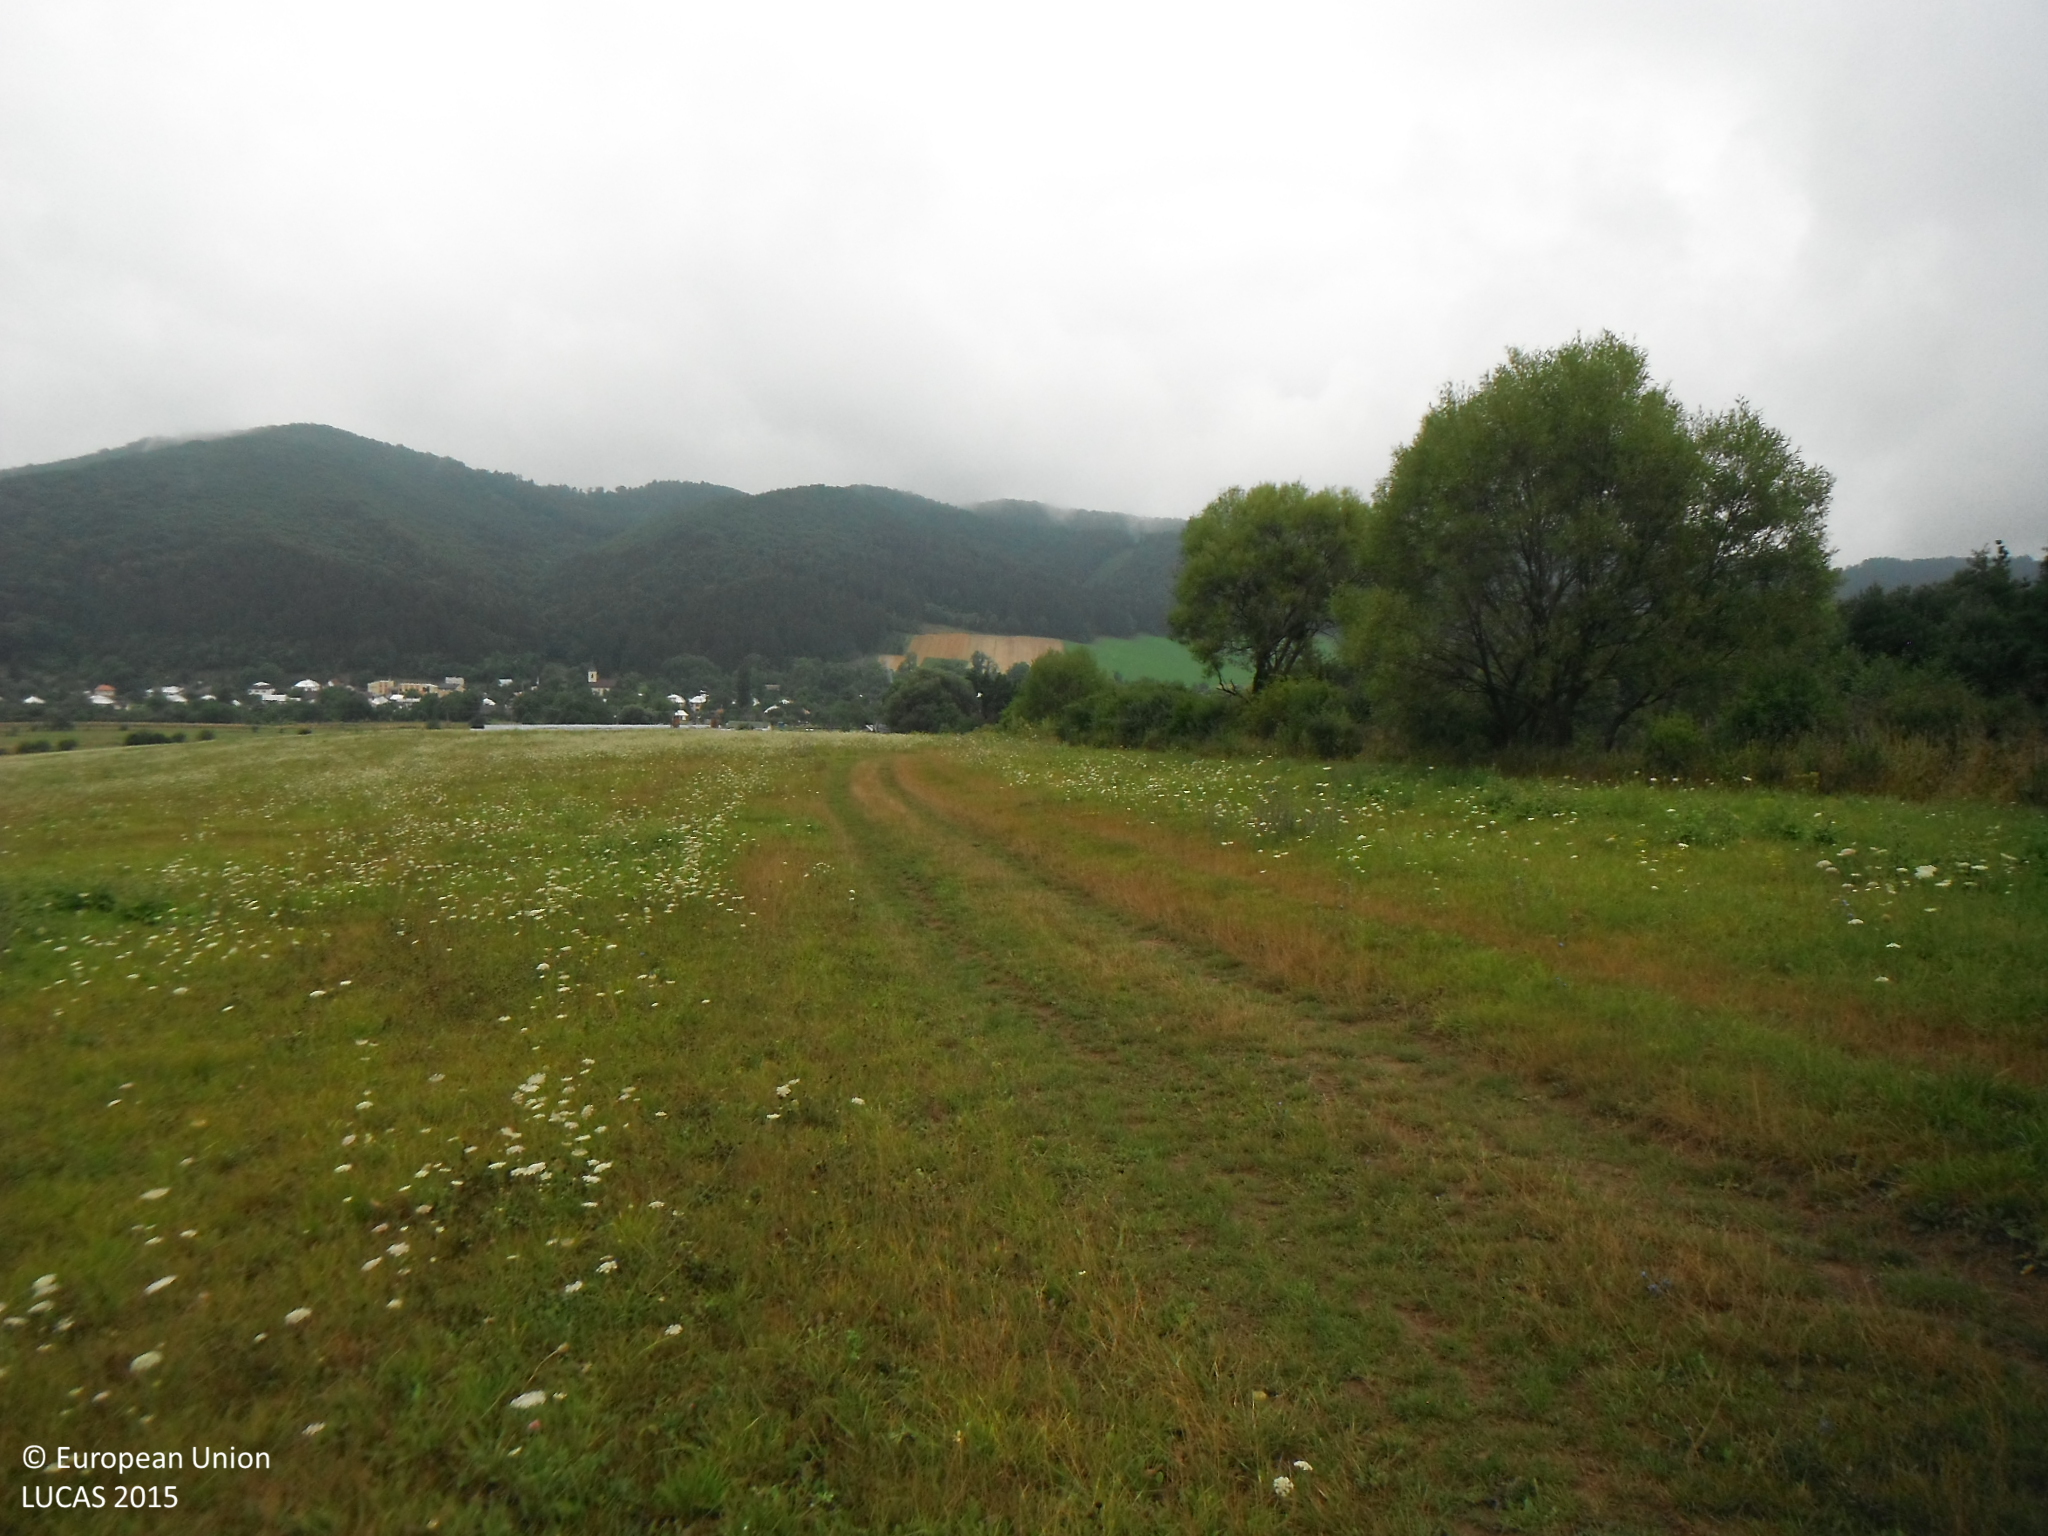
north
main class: Grassland
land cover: Grassland without tree/shrub cover
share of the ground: > 75 %
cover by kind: herbaceous plants 100 %
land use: Agriculture (excluding fallow land and kitchen gardens)
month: July
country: SK
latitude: 48.8971
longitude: 21.9630
